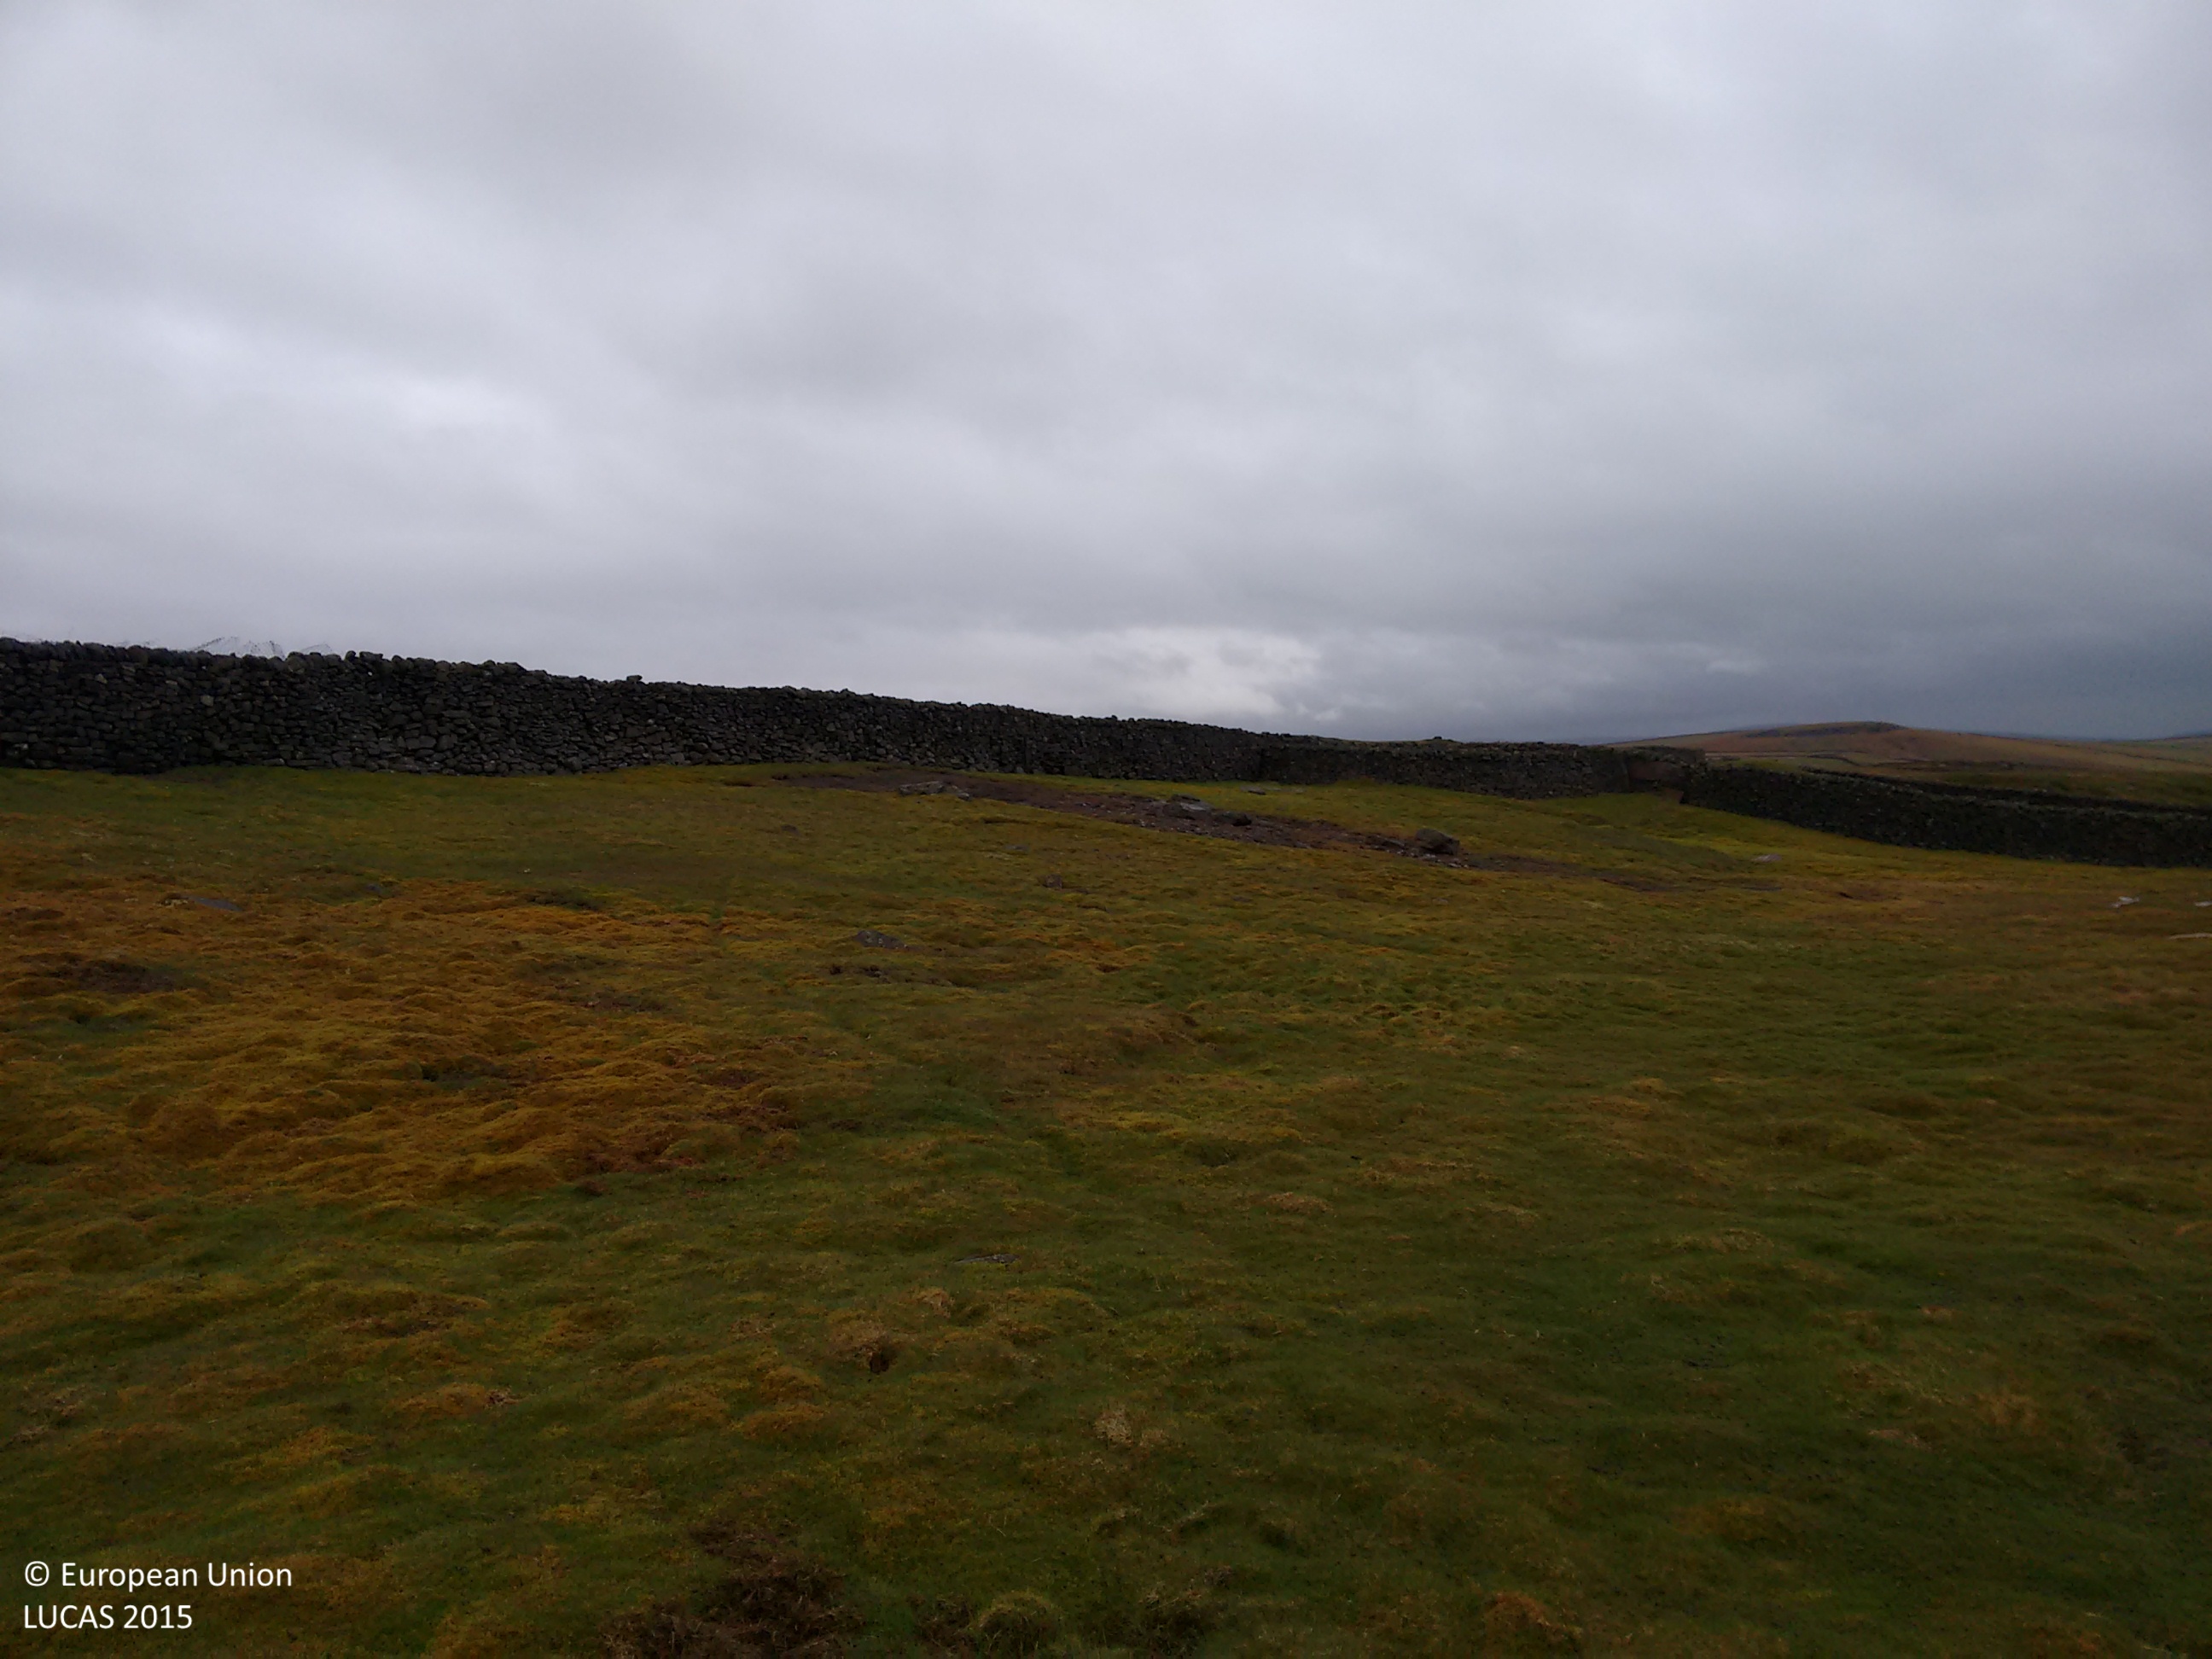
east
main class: Grassland
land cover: Grassland without tree/shrub cover
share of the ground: > 75 %
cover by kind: herbaceous plants 100 %
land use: Agriculture (excluding fallow land and kitchen gardens)
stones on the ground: < 10 %
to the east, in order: Grassland without tree/shrub cover; Dry stone walls; Grassland without tree/shrub cover; Tracks; Grassland without tree/shrub cover
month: June
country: GB
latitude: 54.0970
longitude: -1.9679
